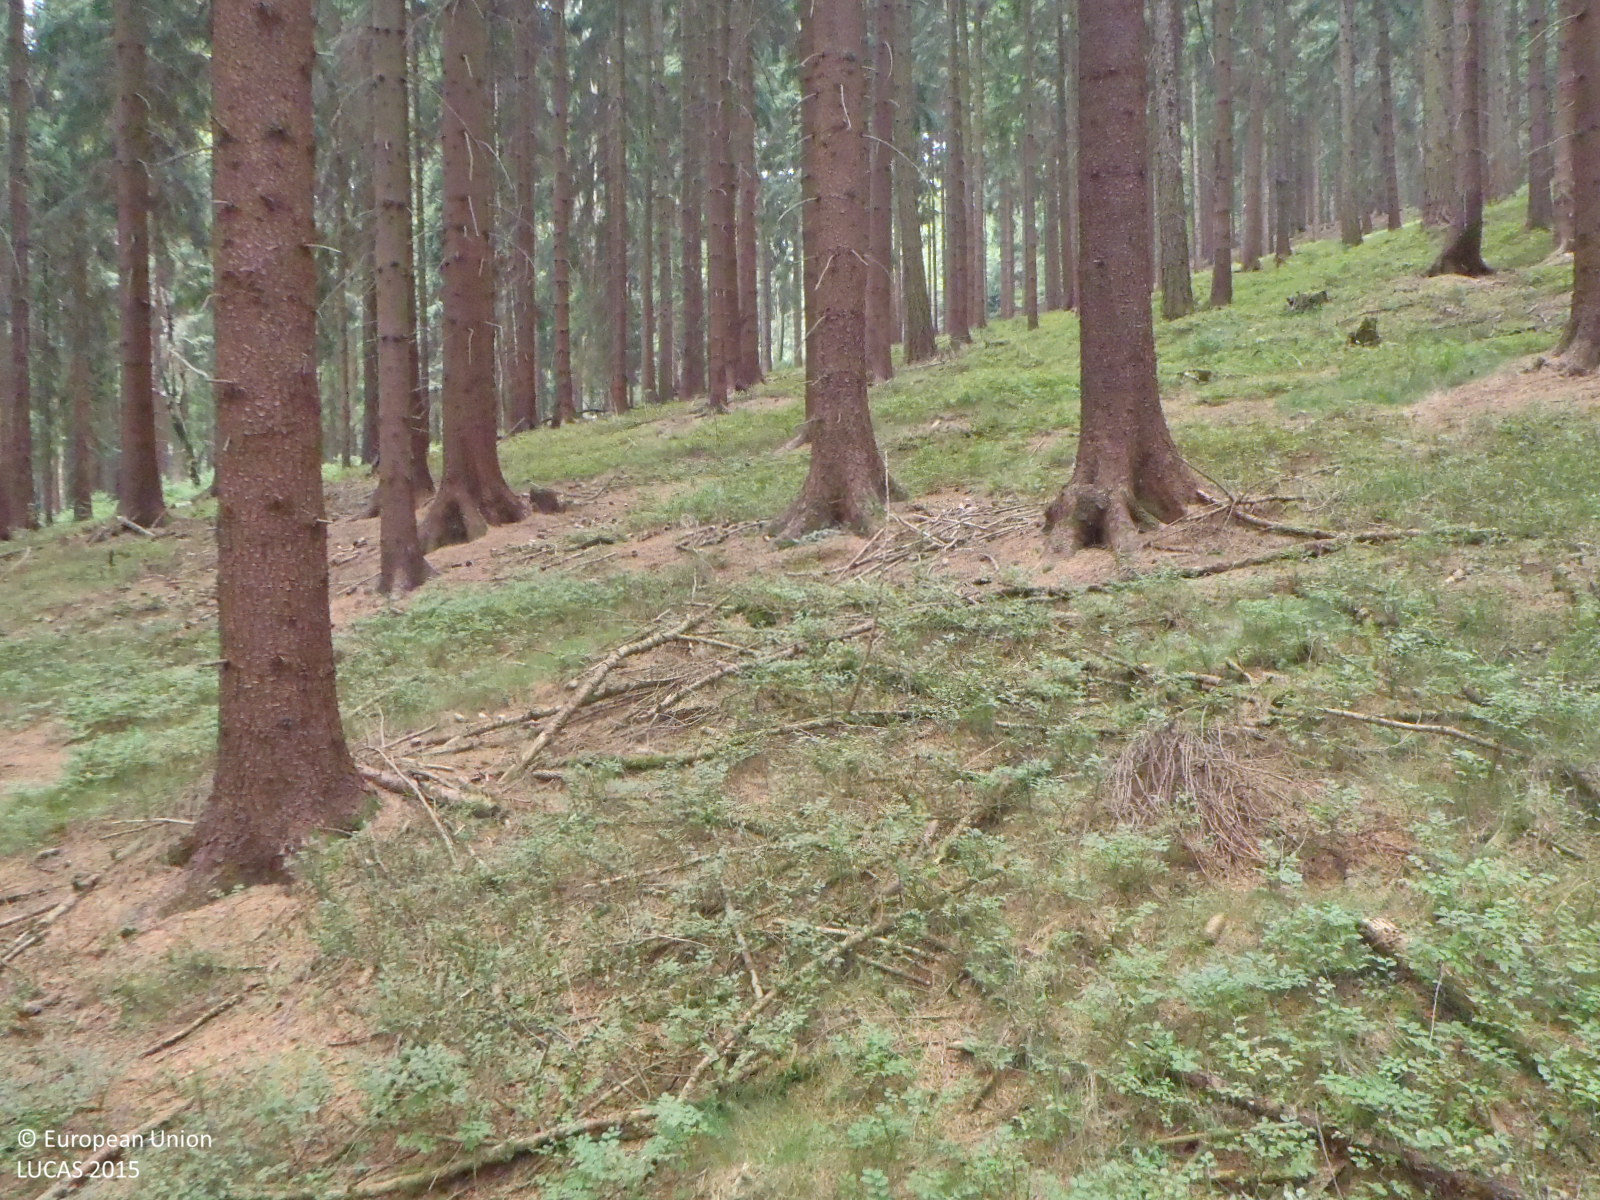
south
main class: Woodland
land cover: Spruce dominated coniferous woodland
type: hemiboreal forest and nemoral coniferous forest and mixed broadleaved-coniferous forest
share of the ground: > 75 %
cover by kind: coniferous forest trees 100 %
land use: Forestry
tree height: > 5 m
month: August
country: CZ
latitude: 50.7601
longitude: 14.9788
